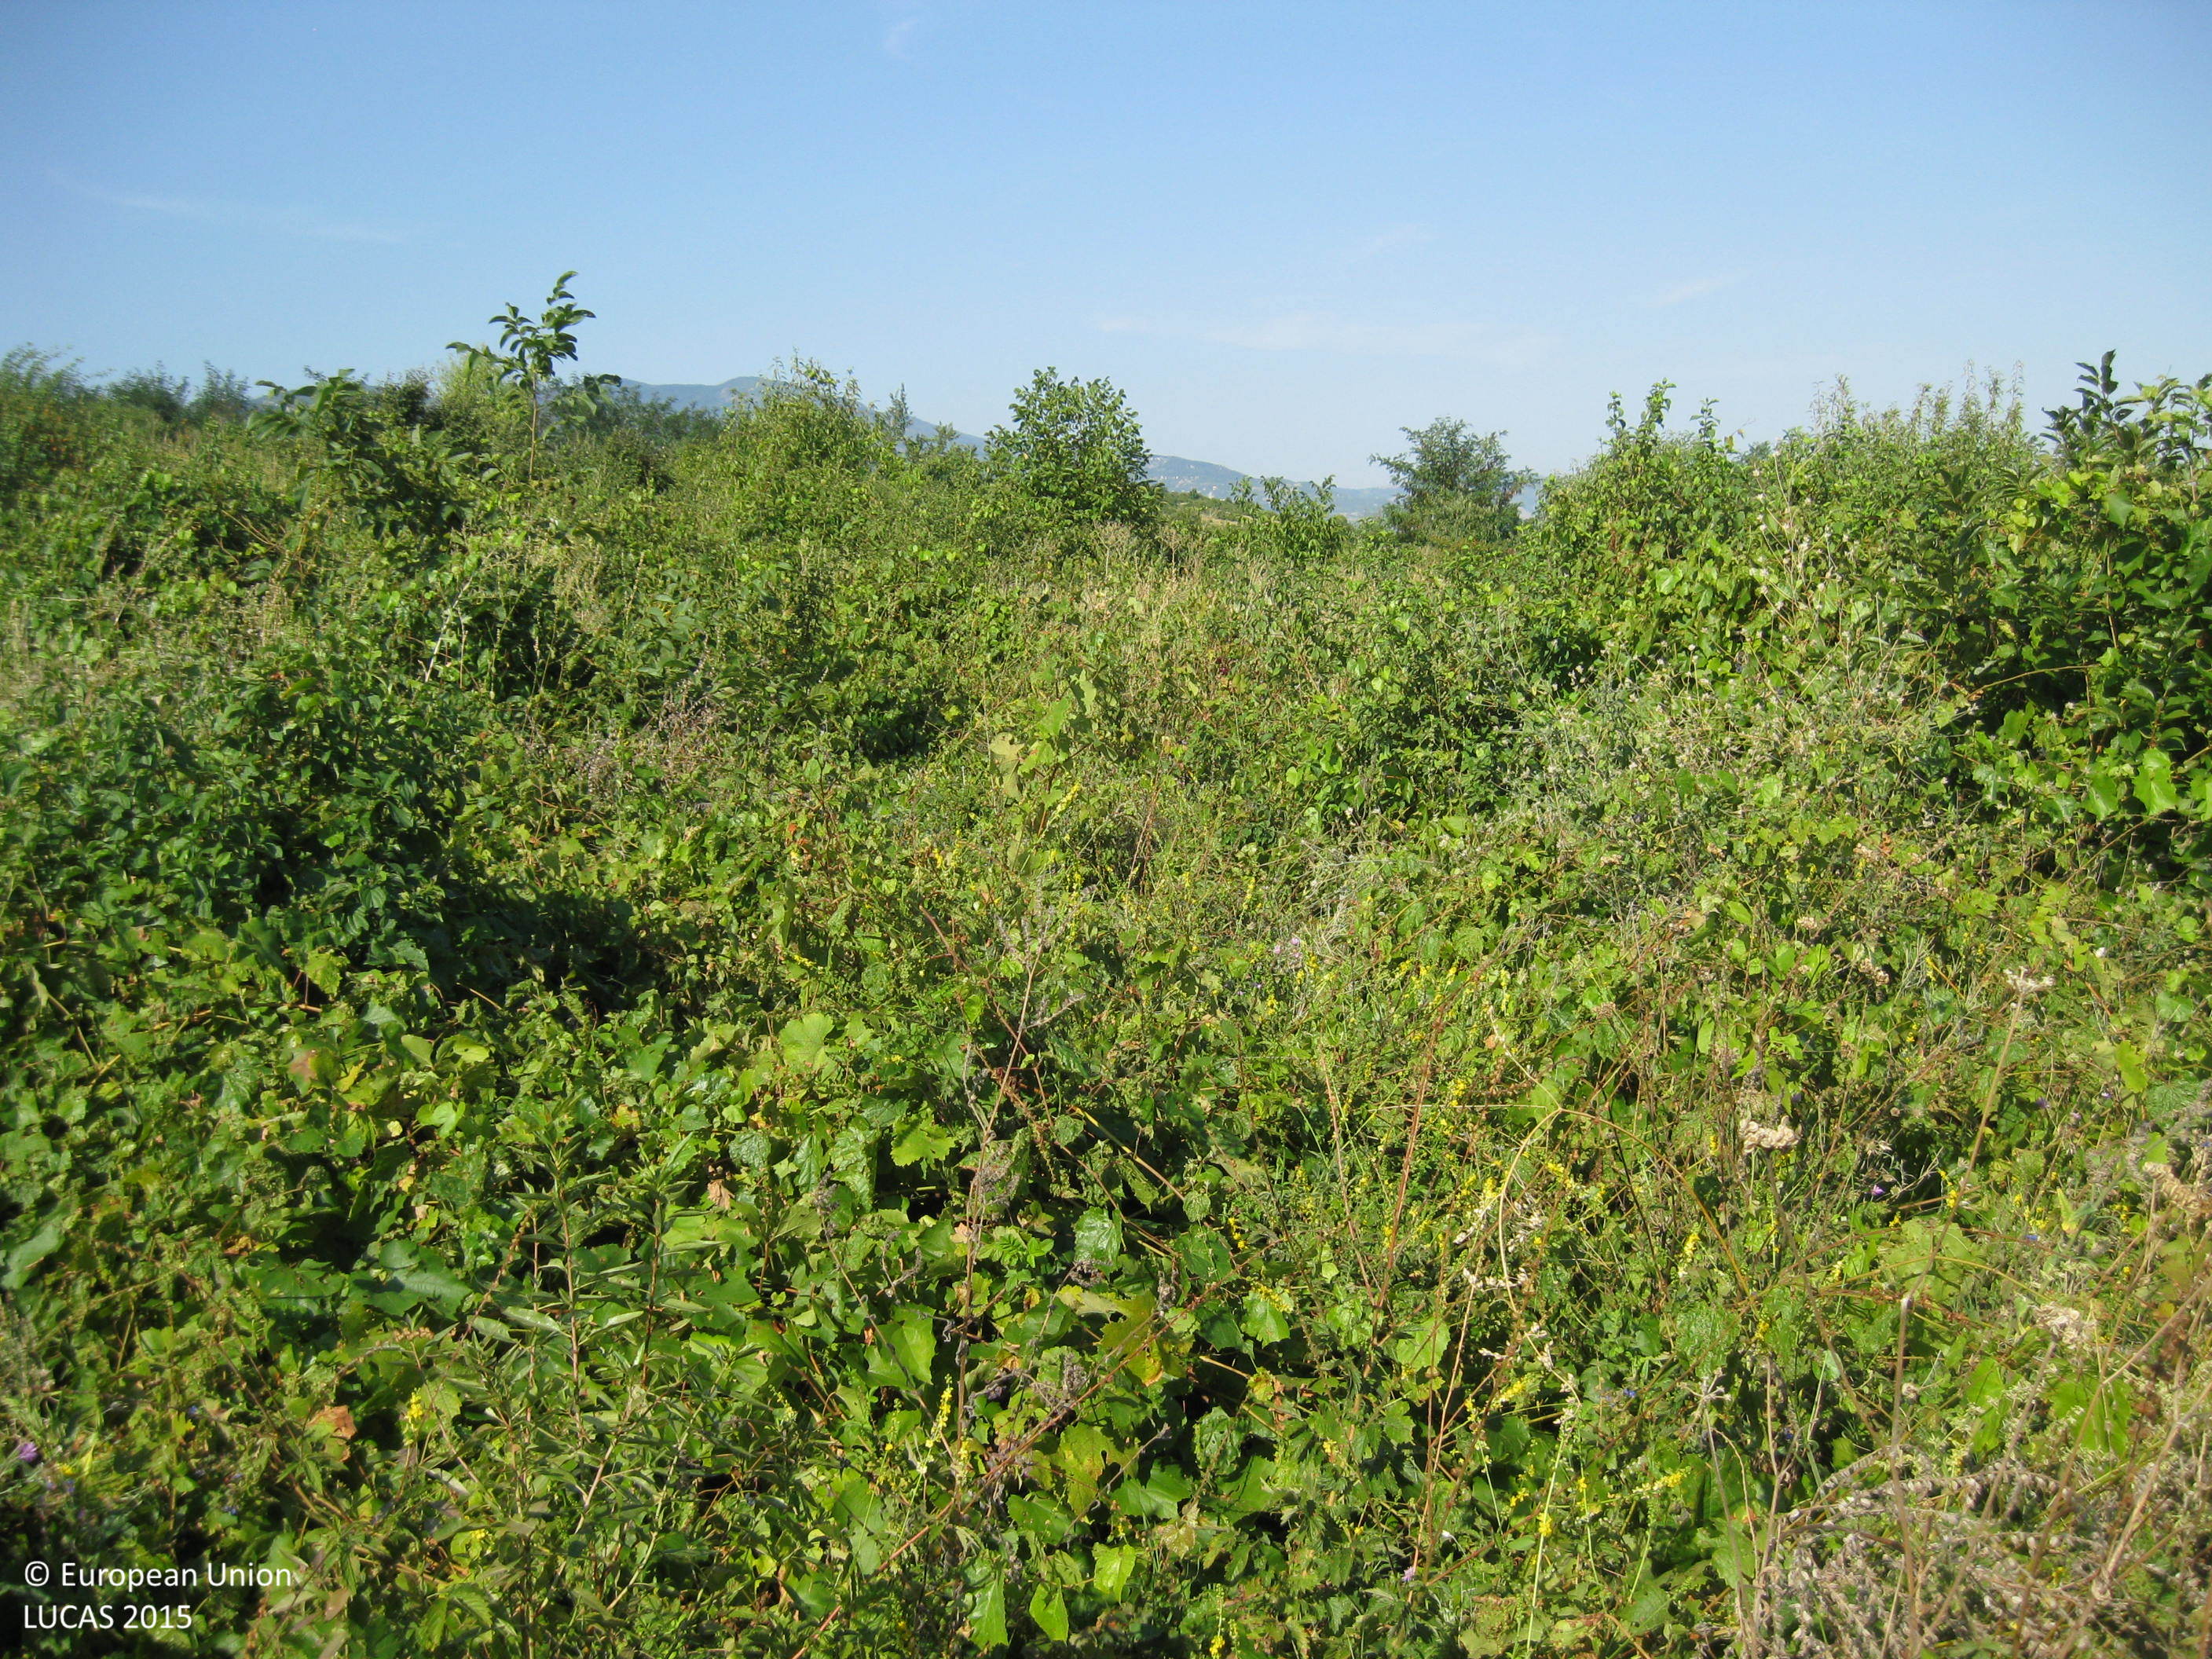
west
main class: Cropland
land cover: Vineyards
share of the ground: > 75 %
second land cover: Spontaneously vegetated surfaces
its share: > 75 %
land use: Agriculture (excluding fallow land and kitchen gardens)
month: August
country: BG
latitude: 42.0187
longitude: 24.9190
